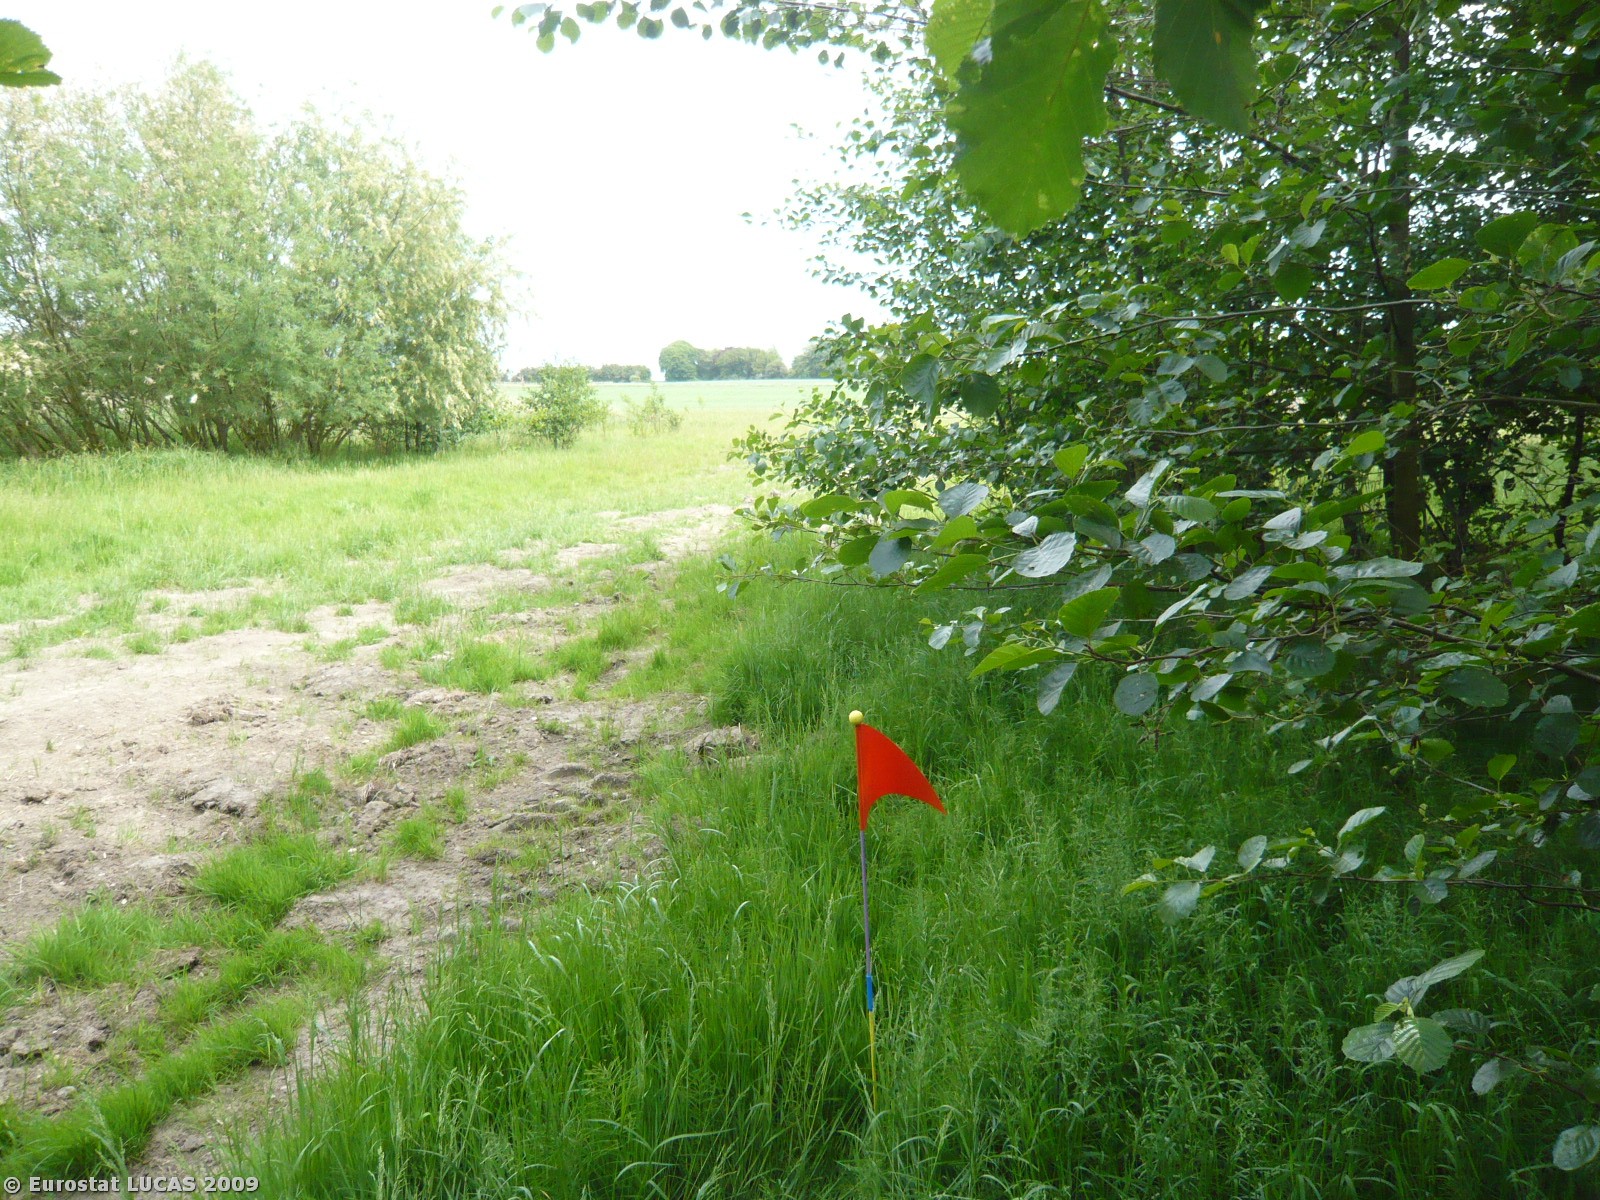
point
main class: Woodland
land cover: Broadleaved woodland
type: mire and swamp forests
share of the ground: > 75 %
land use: Unused
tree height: > 5 m
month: June
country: DK
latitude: 55.2456
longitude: 11.3673
